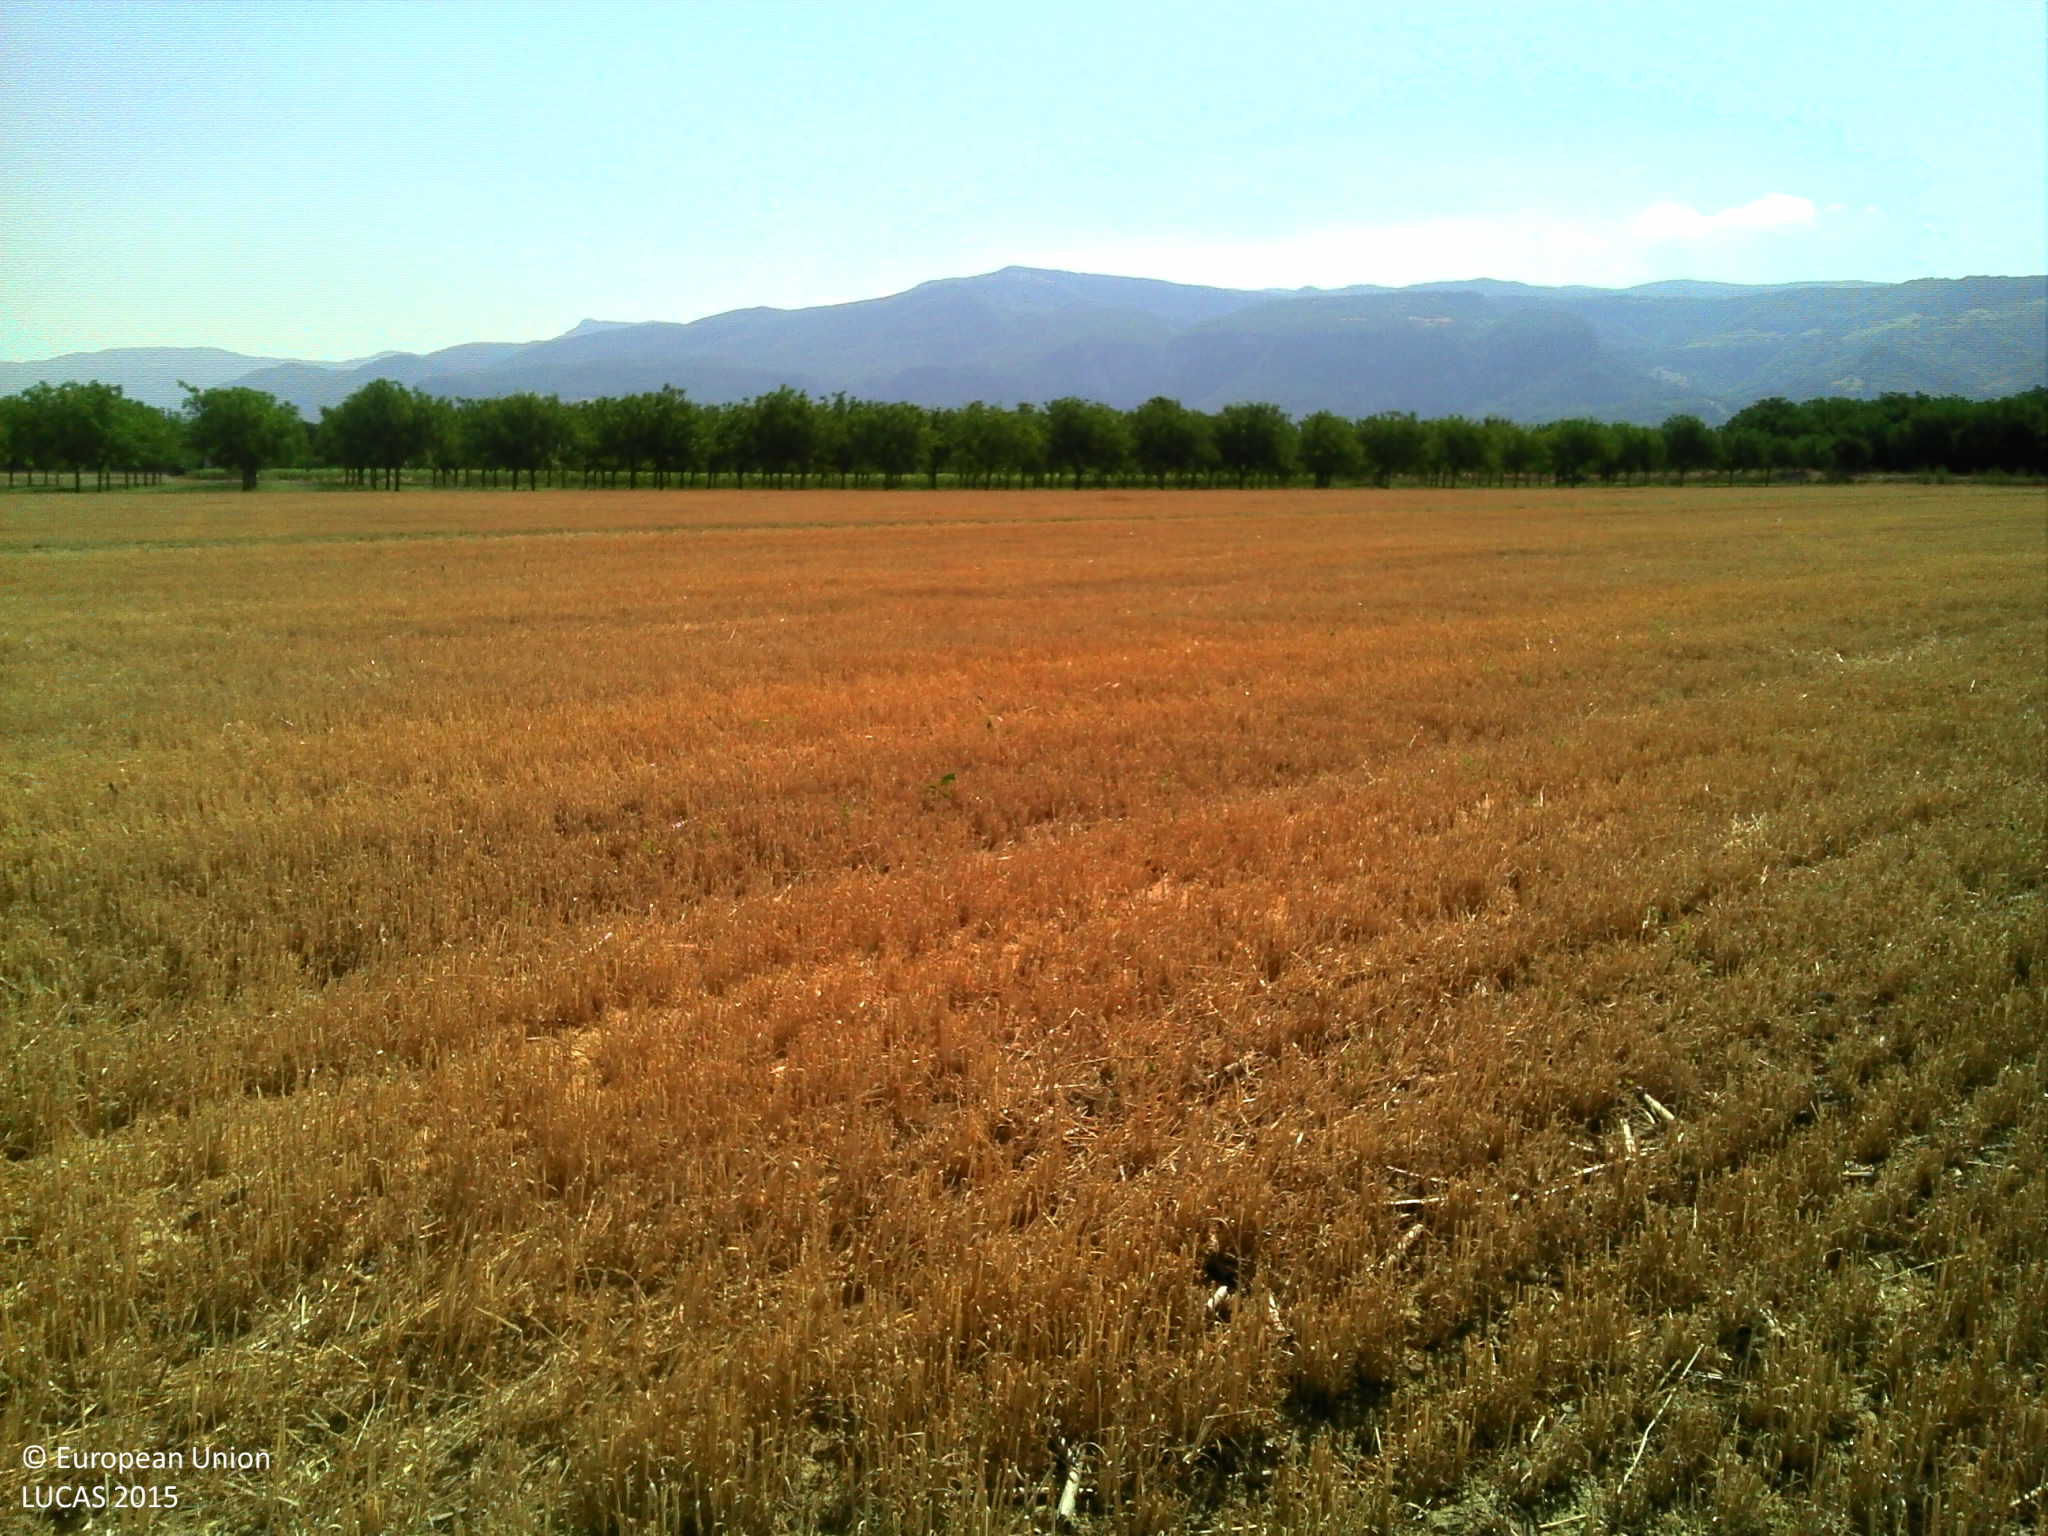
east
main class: Cropland
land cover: Durum wheat
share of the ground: > 75 %
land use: Agriculture (excluding fallow land and kitchen gardens)
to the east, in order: Durum wheat; Tracks; Durum wheat; Nuts trees; Grassland without tree/shrub cover; Nuts trees
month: July
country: FR
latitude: 45.1285
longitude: 5.2884
